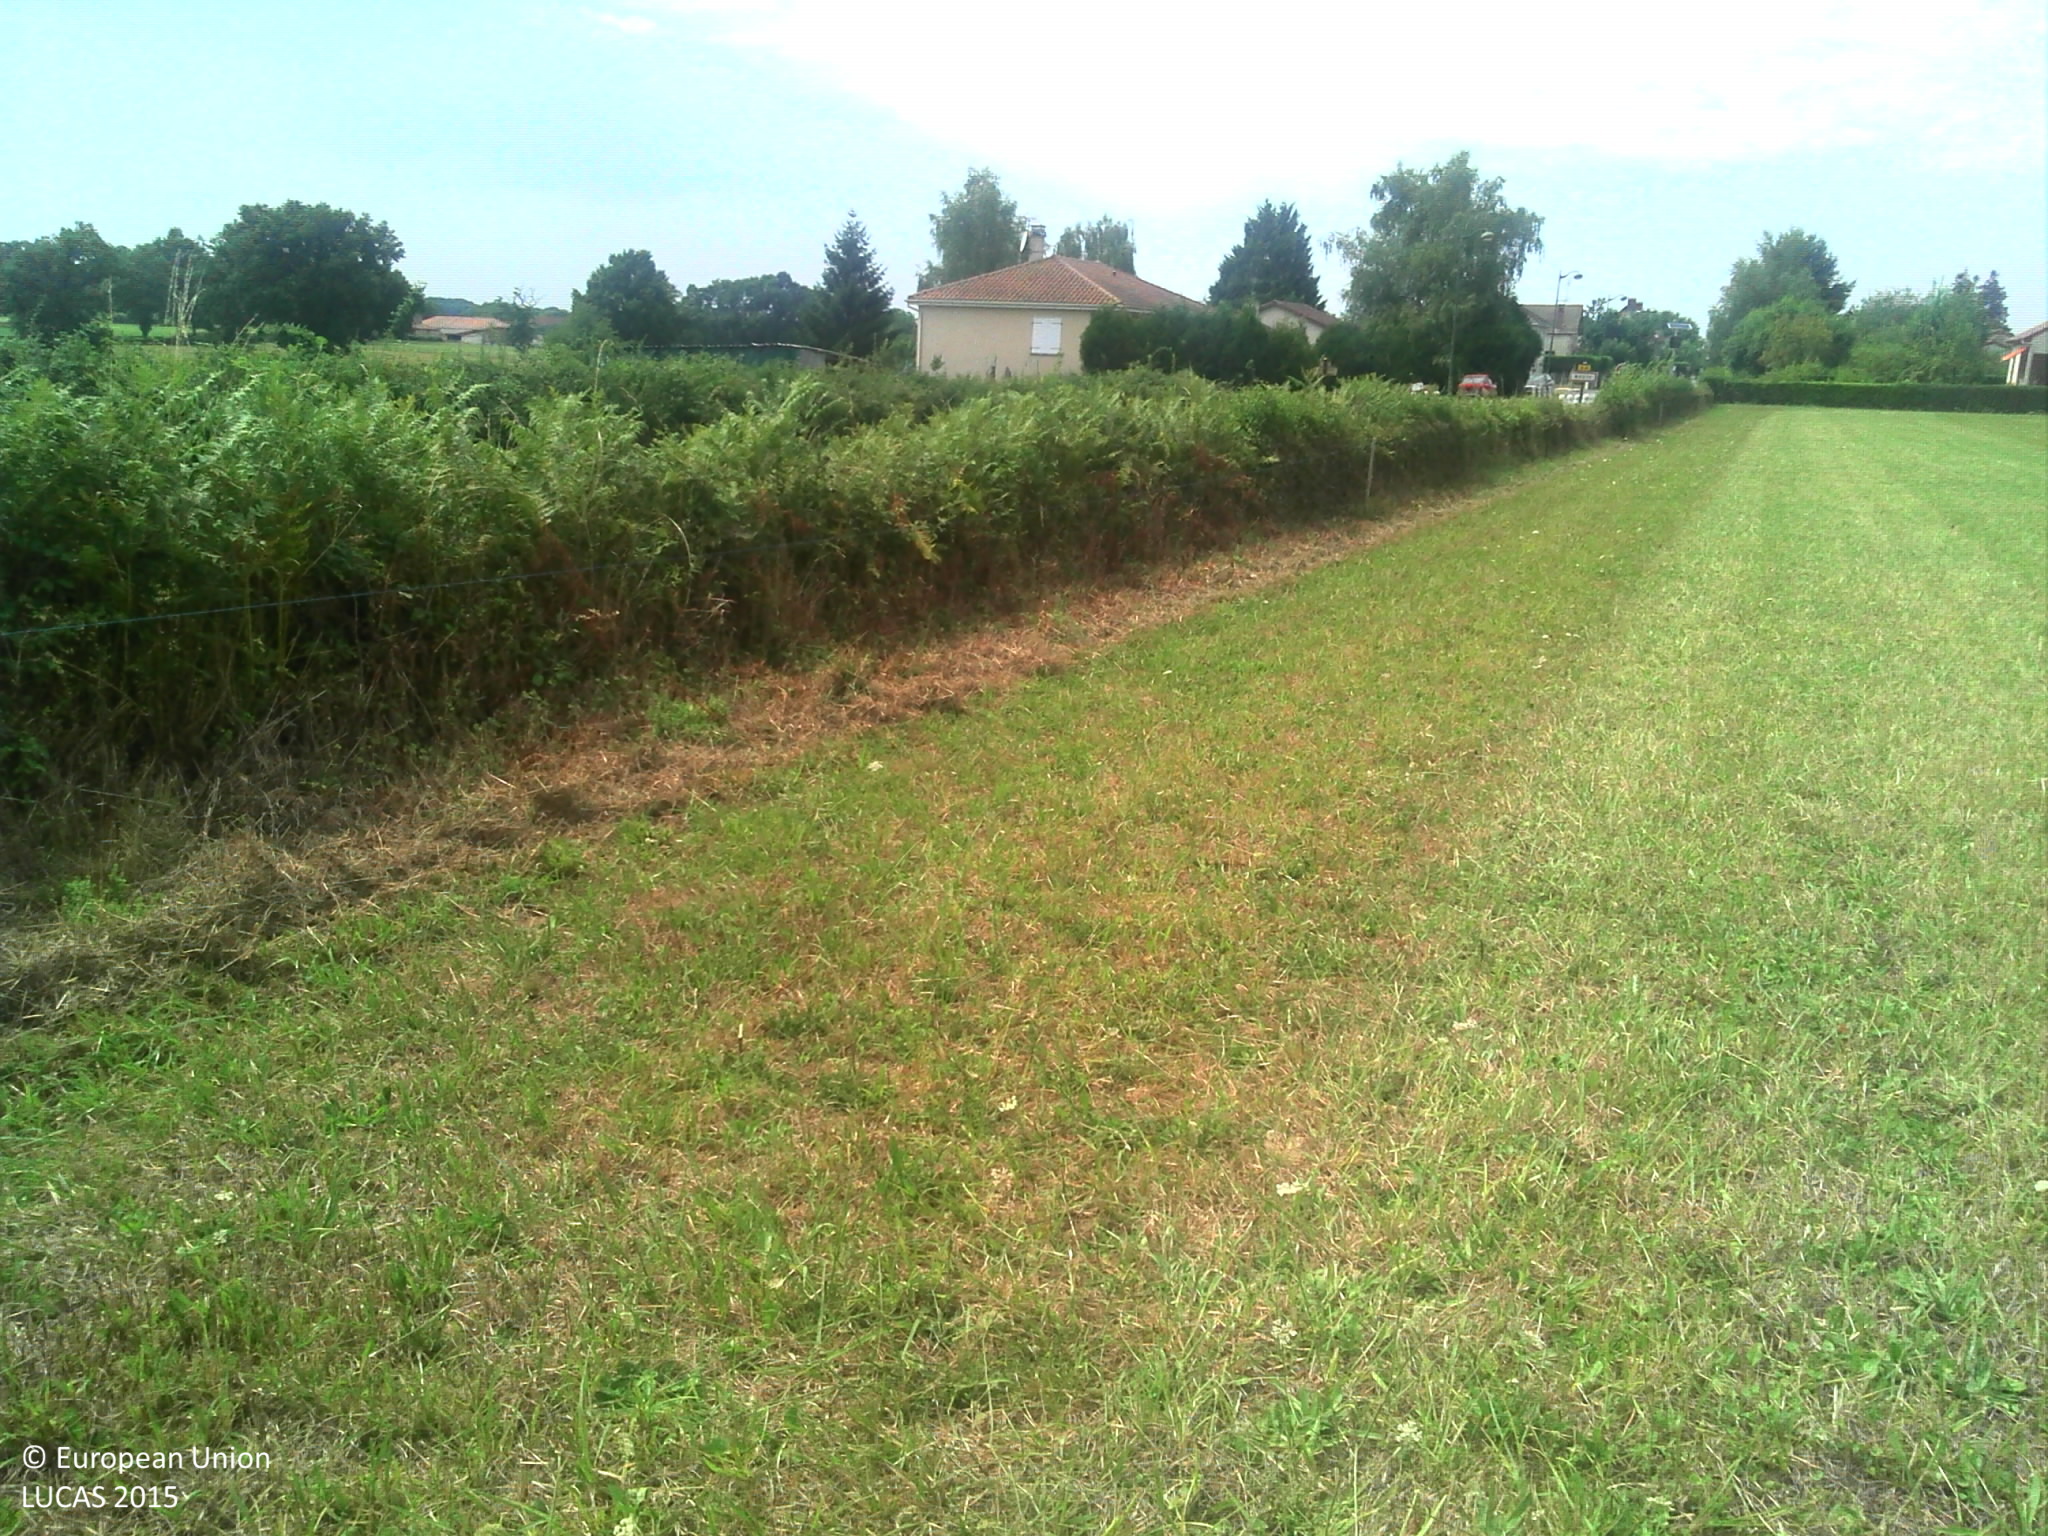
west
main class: Grassland
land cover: Grassland without tree/shrub cover
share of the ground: > 75 %
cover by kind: herbaceous plants 100 %
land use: Agriculture (excluding fallow land and kitchen gardens)
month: August
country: FR
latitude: 46.0555
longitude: 0.9270
